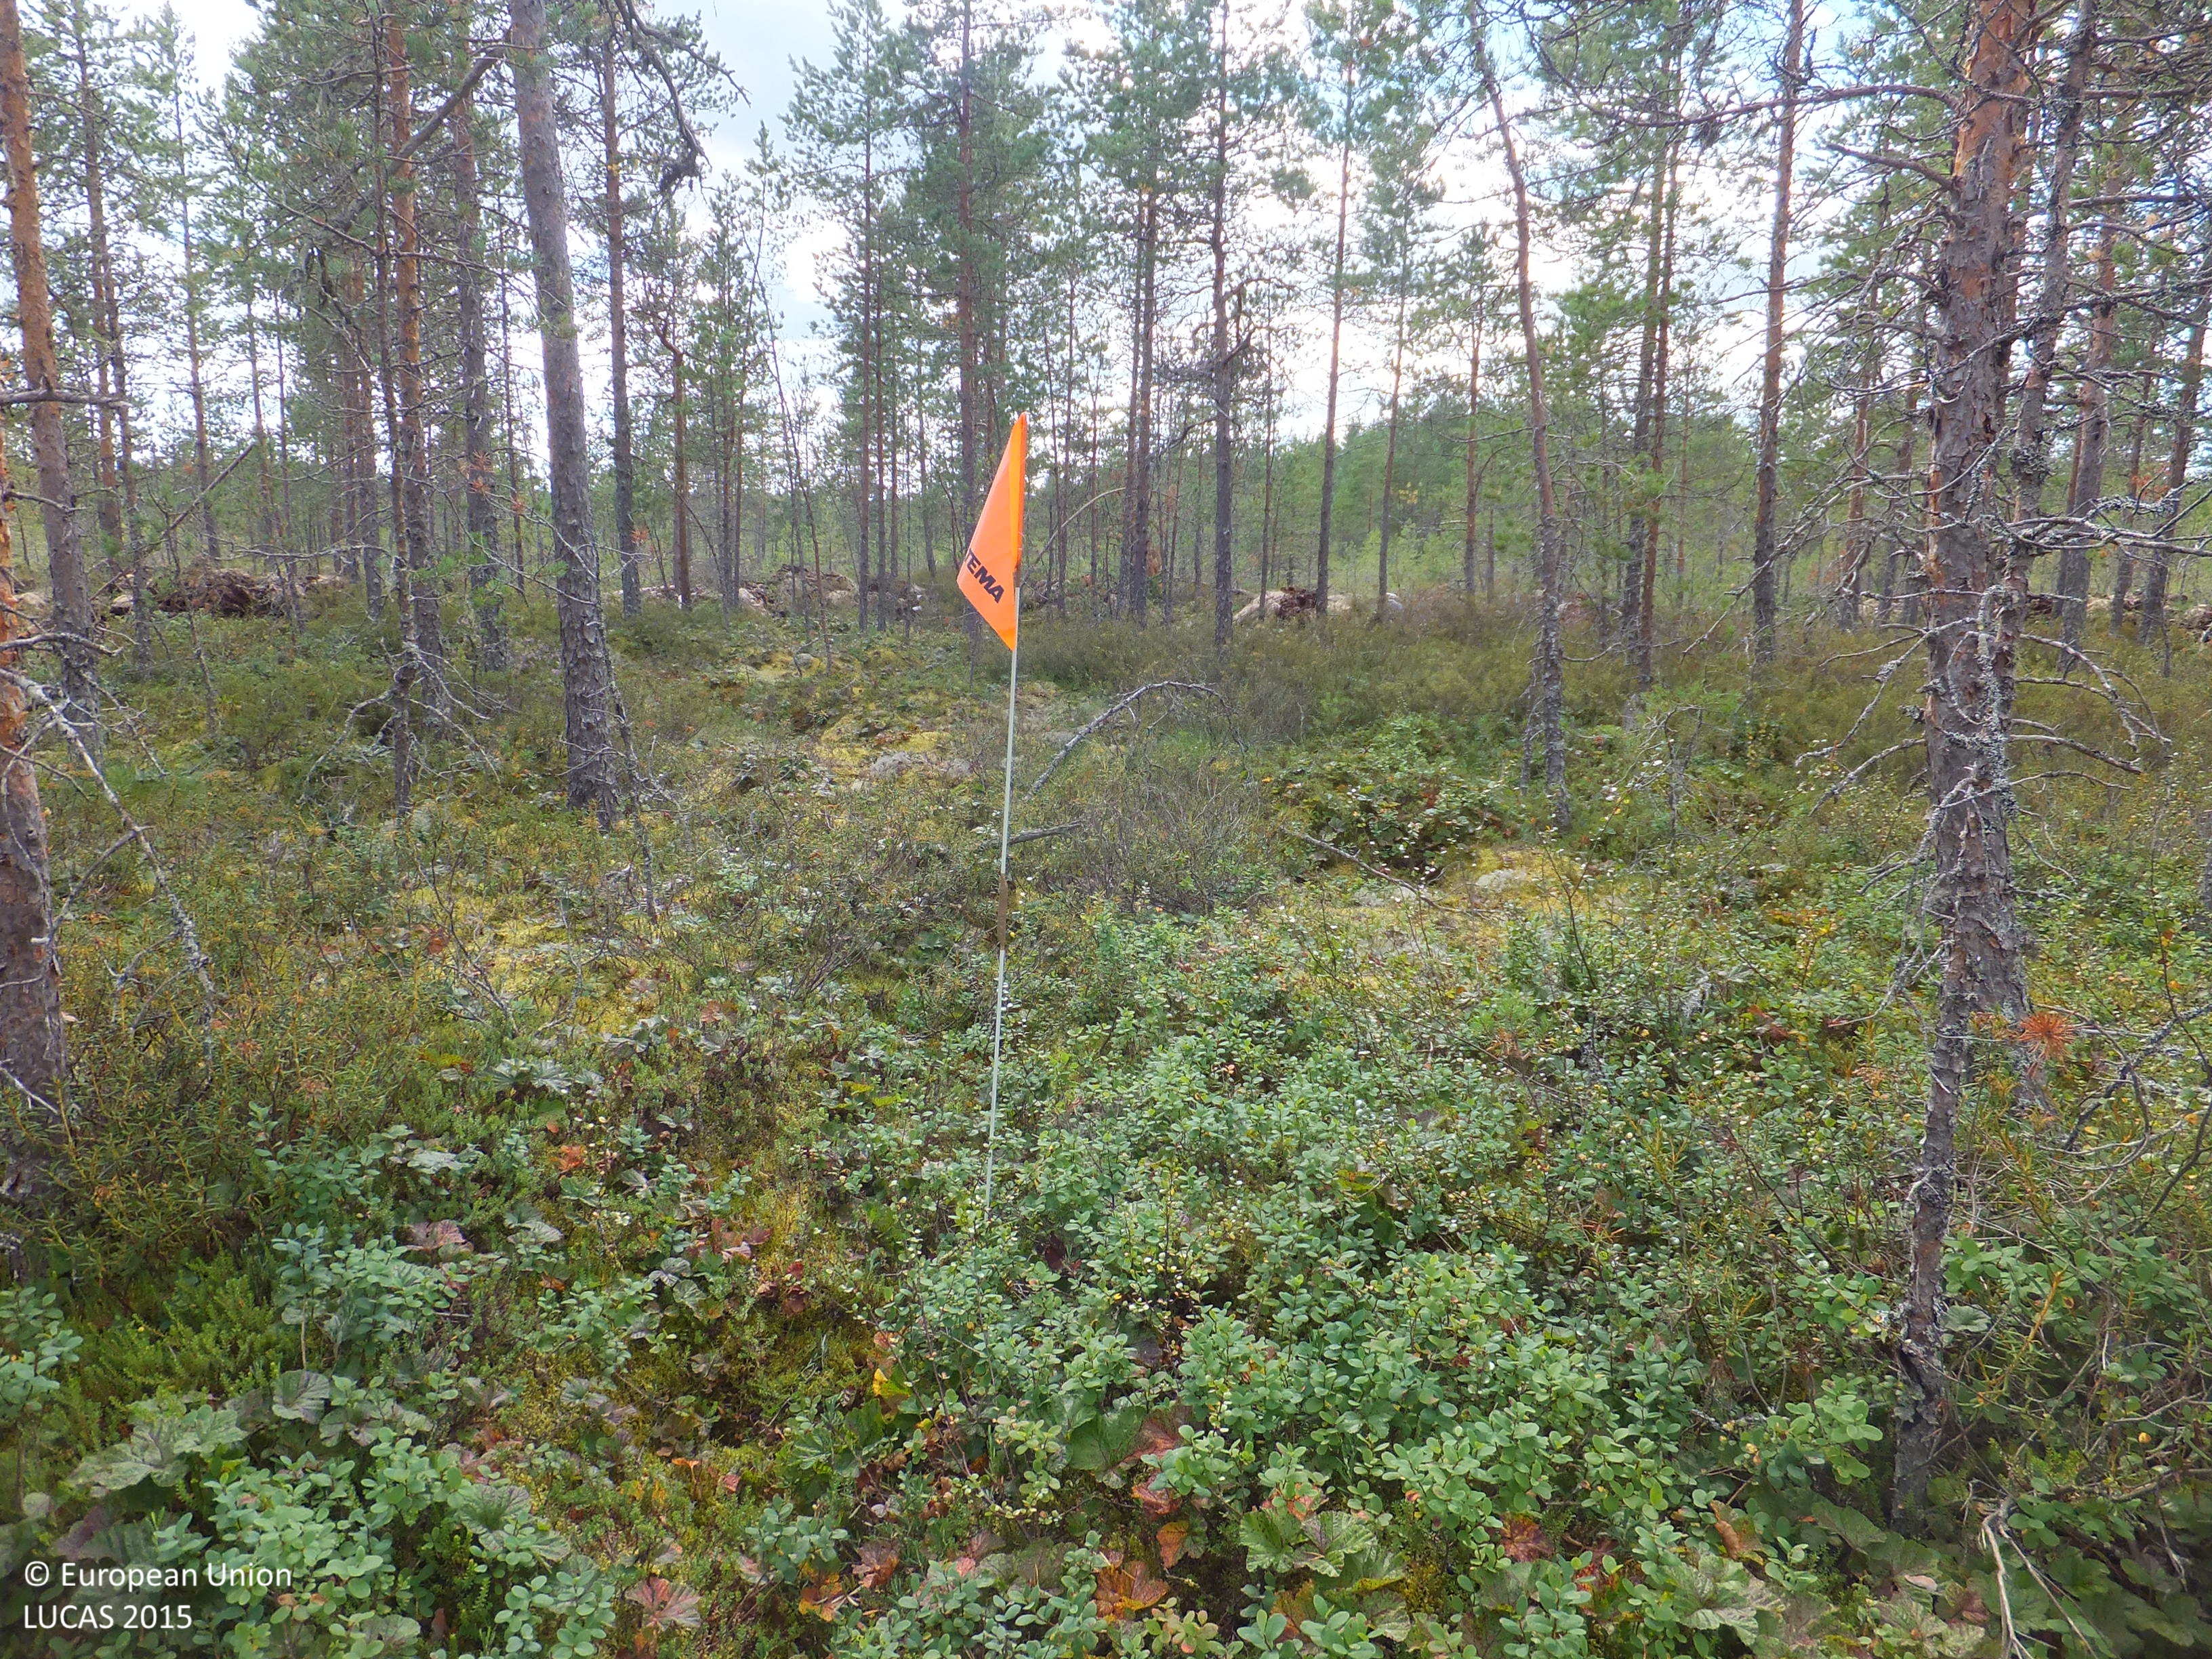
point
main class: Woodland
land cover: Pine dominated coniferous woodland
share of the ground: 25 - 50 %
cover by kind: coniferous forest trees 45 %, shrubs 25 %, lichens and mosses 20 %, herbaceous plants 10 %
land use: Forestry
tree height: < 5 m
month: August
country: FI
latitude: 63.2726
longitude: 23.4359
